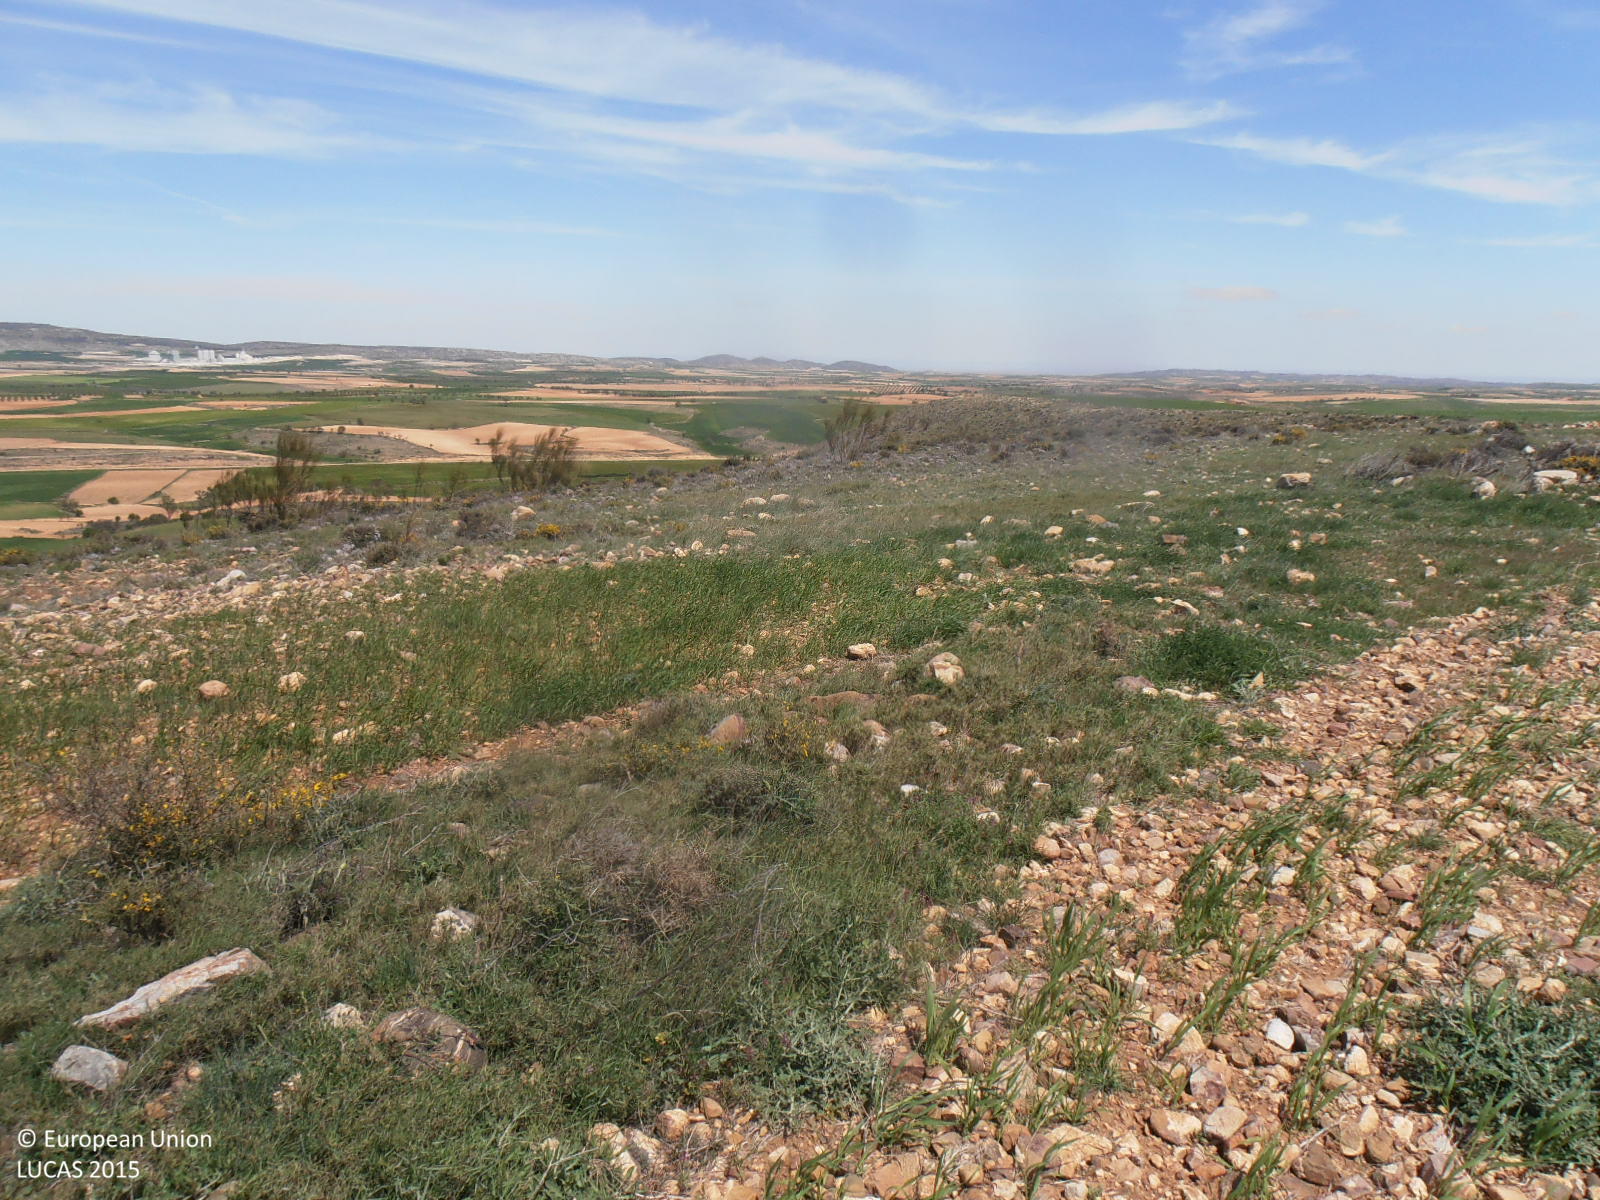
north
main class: Cropland
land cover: Oats
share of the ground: > 75 %
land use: Agriculture (excluding fallow land and kitchen gardens)
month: April
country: ES
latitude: 41.2608
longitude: -0.9157
